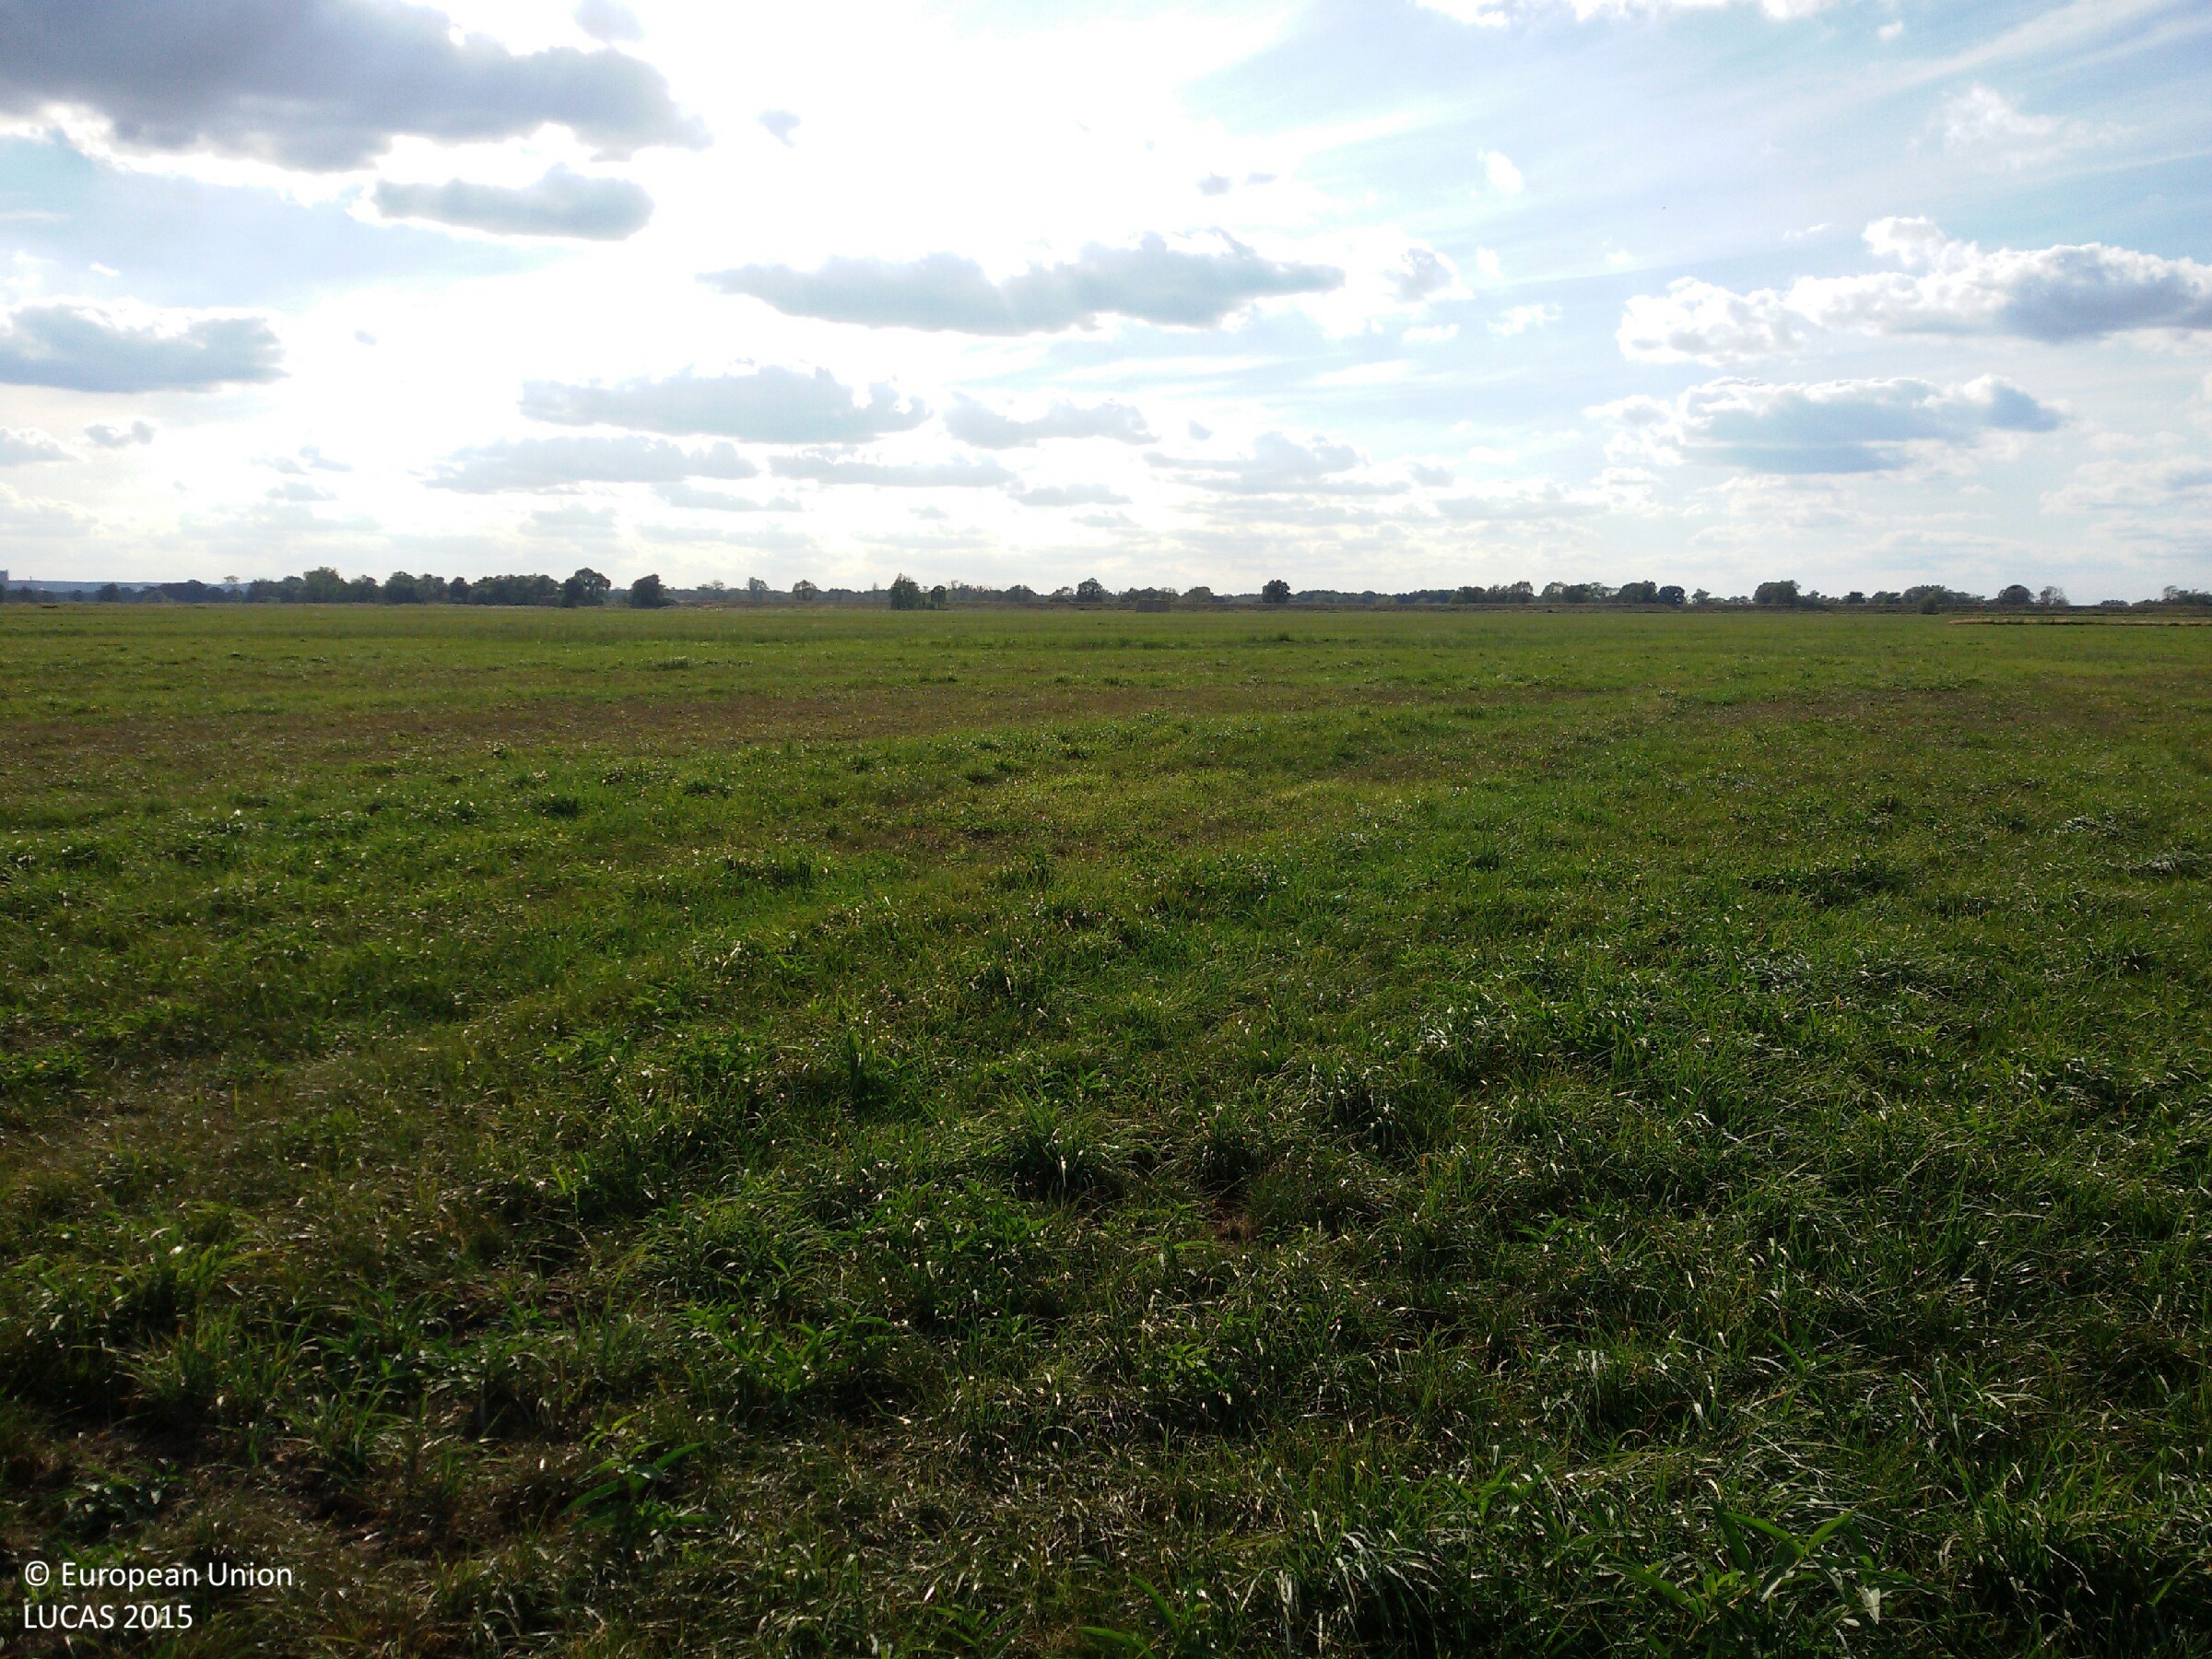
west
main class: Grassland
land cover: Grassland without tree/shrub cover
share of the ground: > 75 %
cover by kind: herbaceous plants 100 %
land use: Agriculture (excluding fallow land and kitchen gardens)
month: September
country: PL
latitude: 52.2113
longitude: 14.7292
